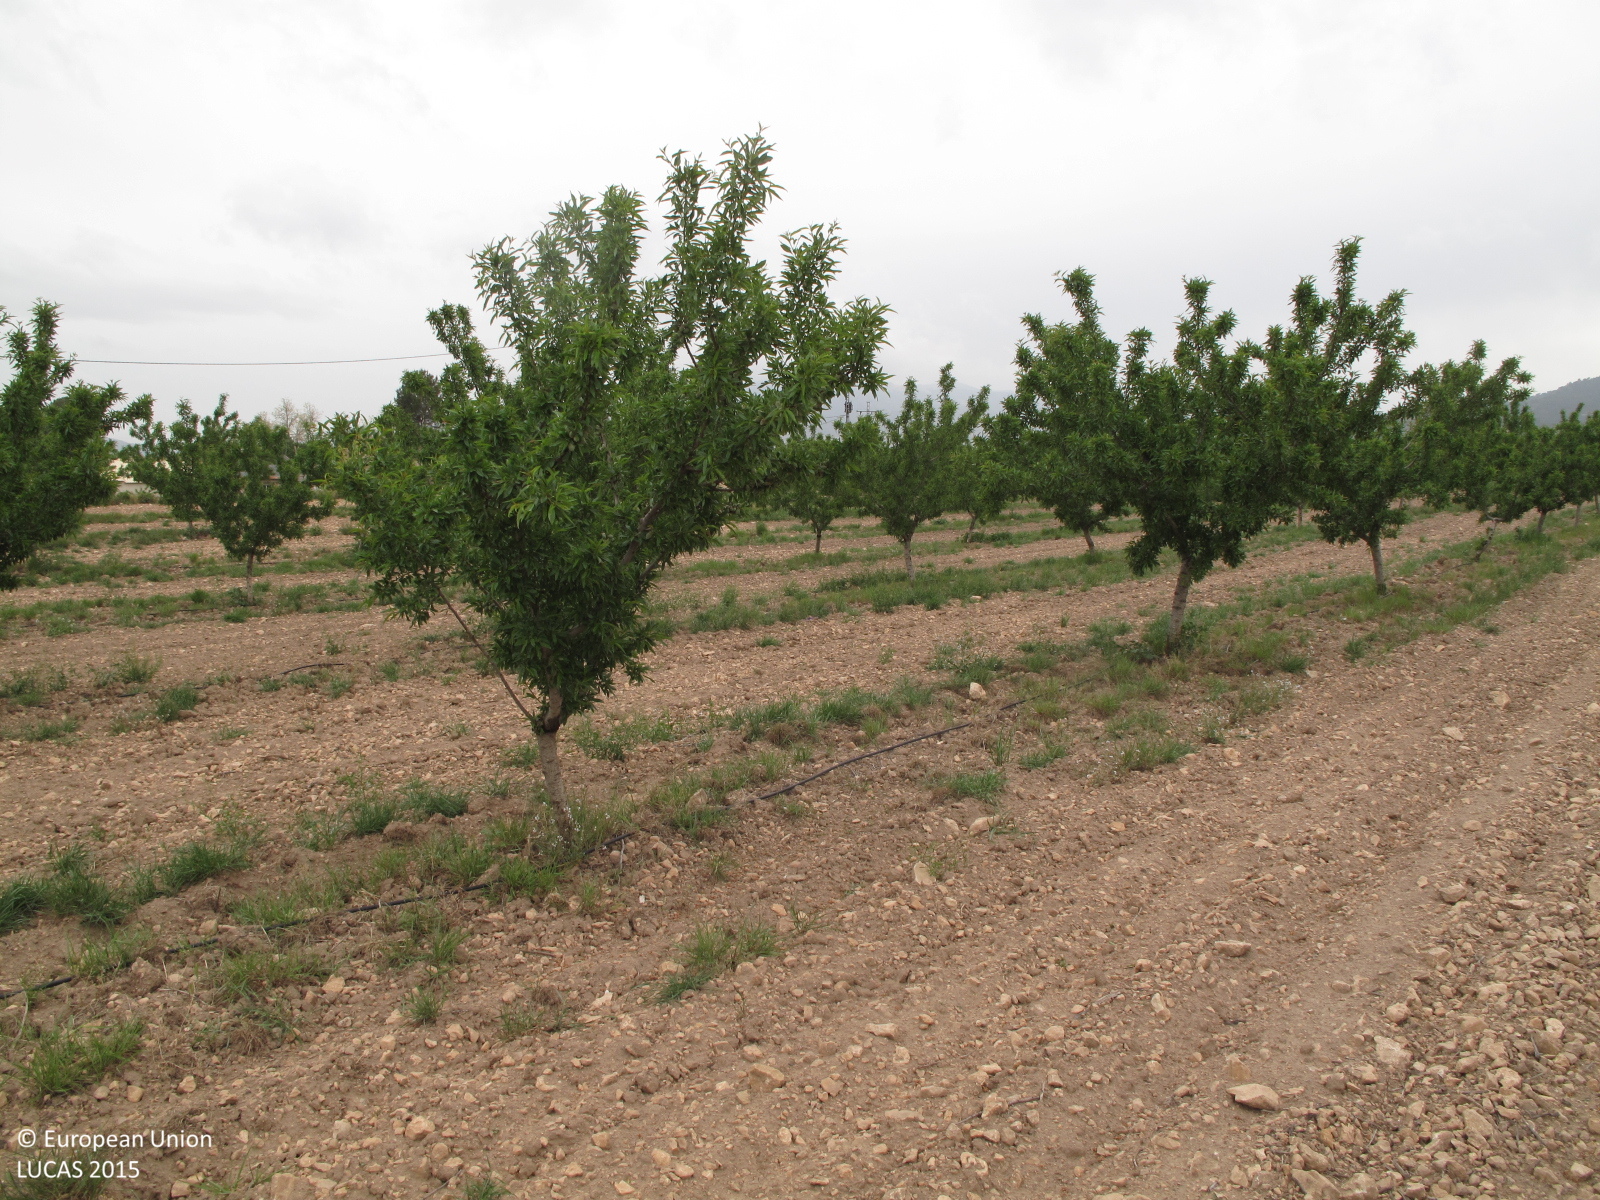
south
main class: Cropland
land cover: Nuts trees
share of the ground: 10 - 25 %
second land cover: Spontaneously vegetated surfaces
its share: 10 - 25 %
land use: Agriculture (excluding fallow land and kitchen gardens)
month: April
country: ES
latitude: 38.4497
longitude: -0.9312
